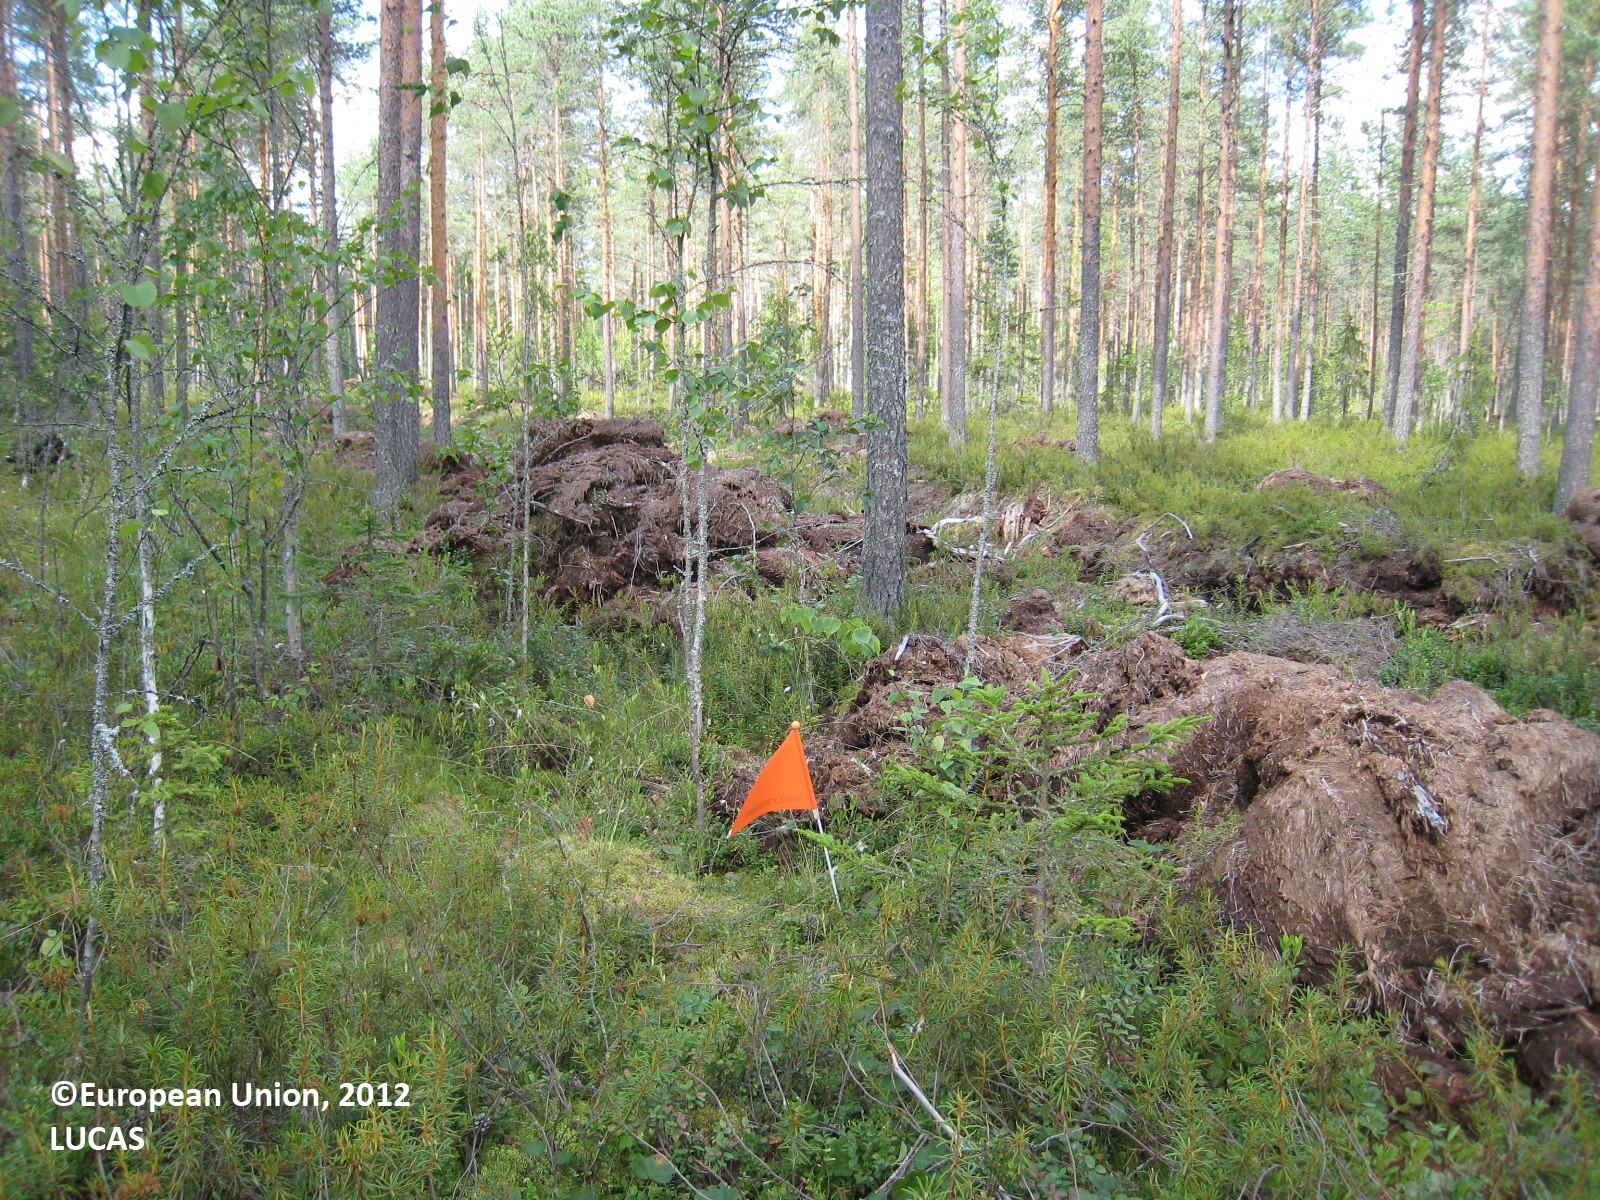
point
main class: Woodland
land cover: Pine dominated coniferous woodland
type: mire and swamp forests
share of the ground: 25 - 50 %
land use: Forestry
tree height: > 5 m
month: July
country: FI
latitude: 62.6546
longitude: 27.3121
